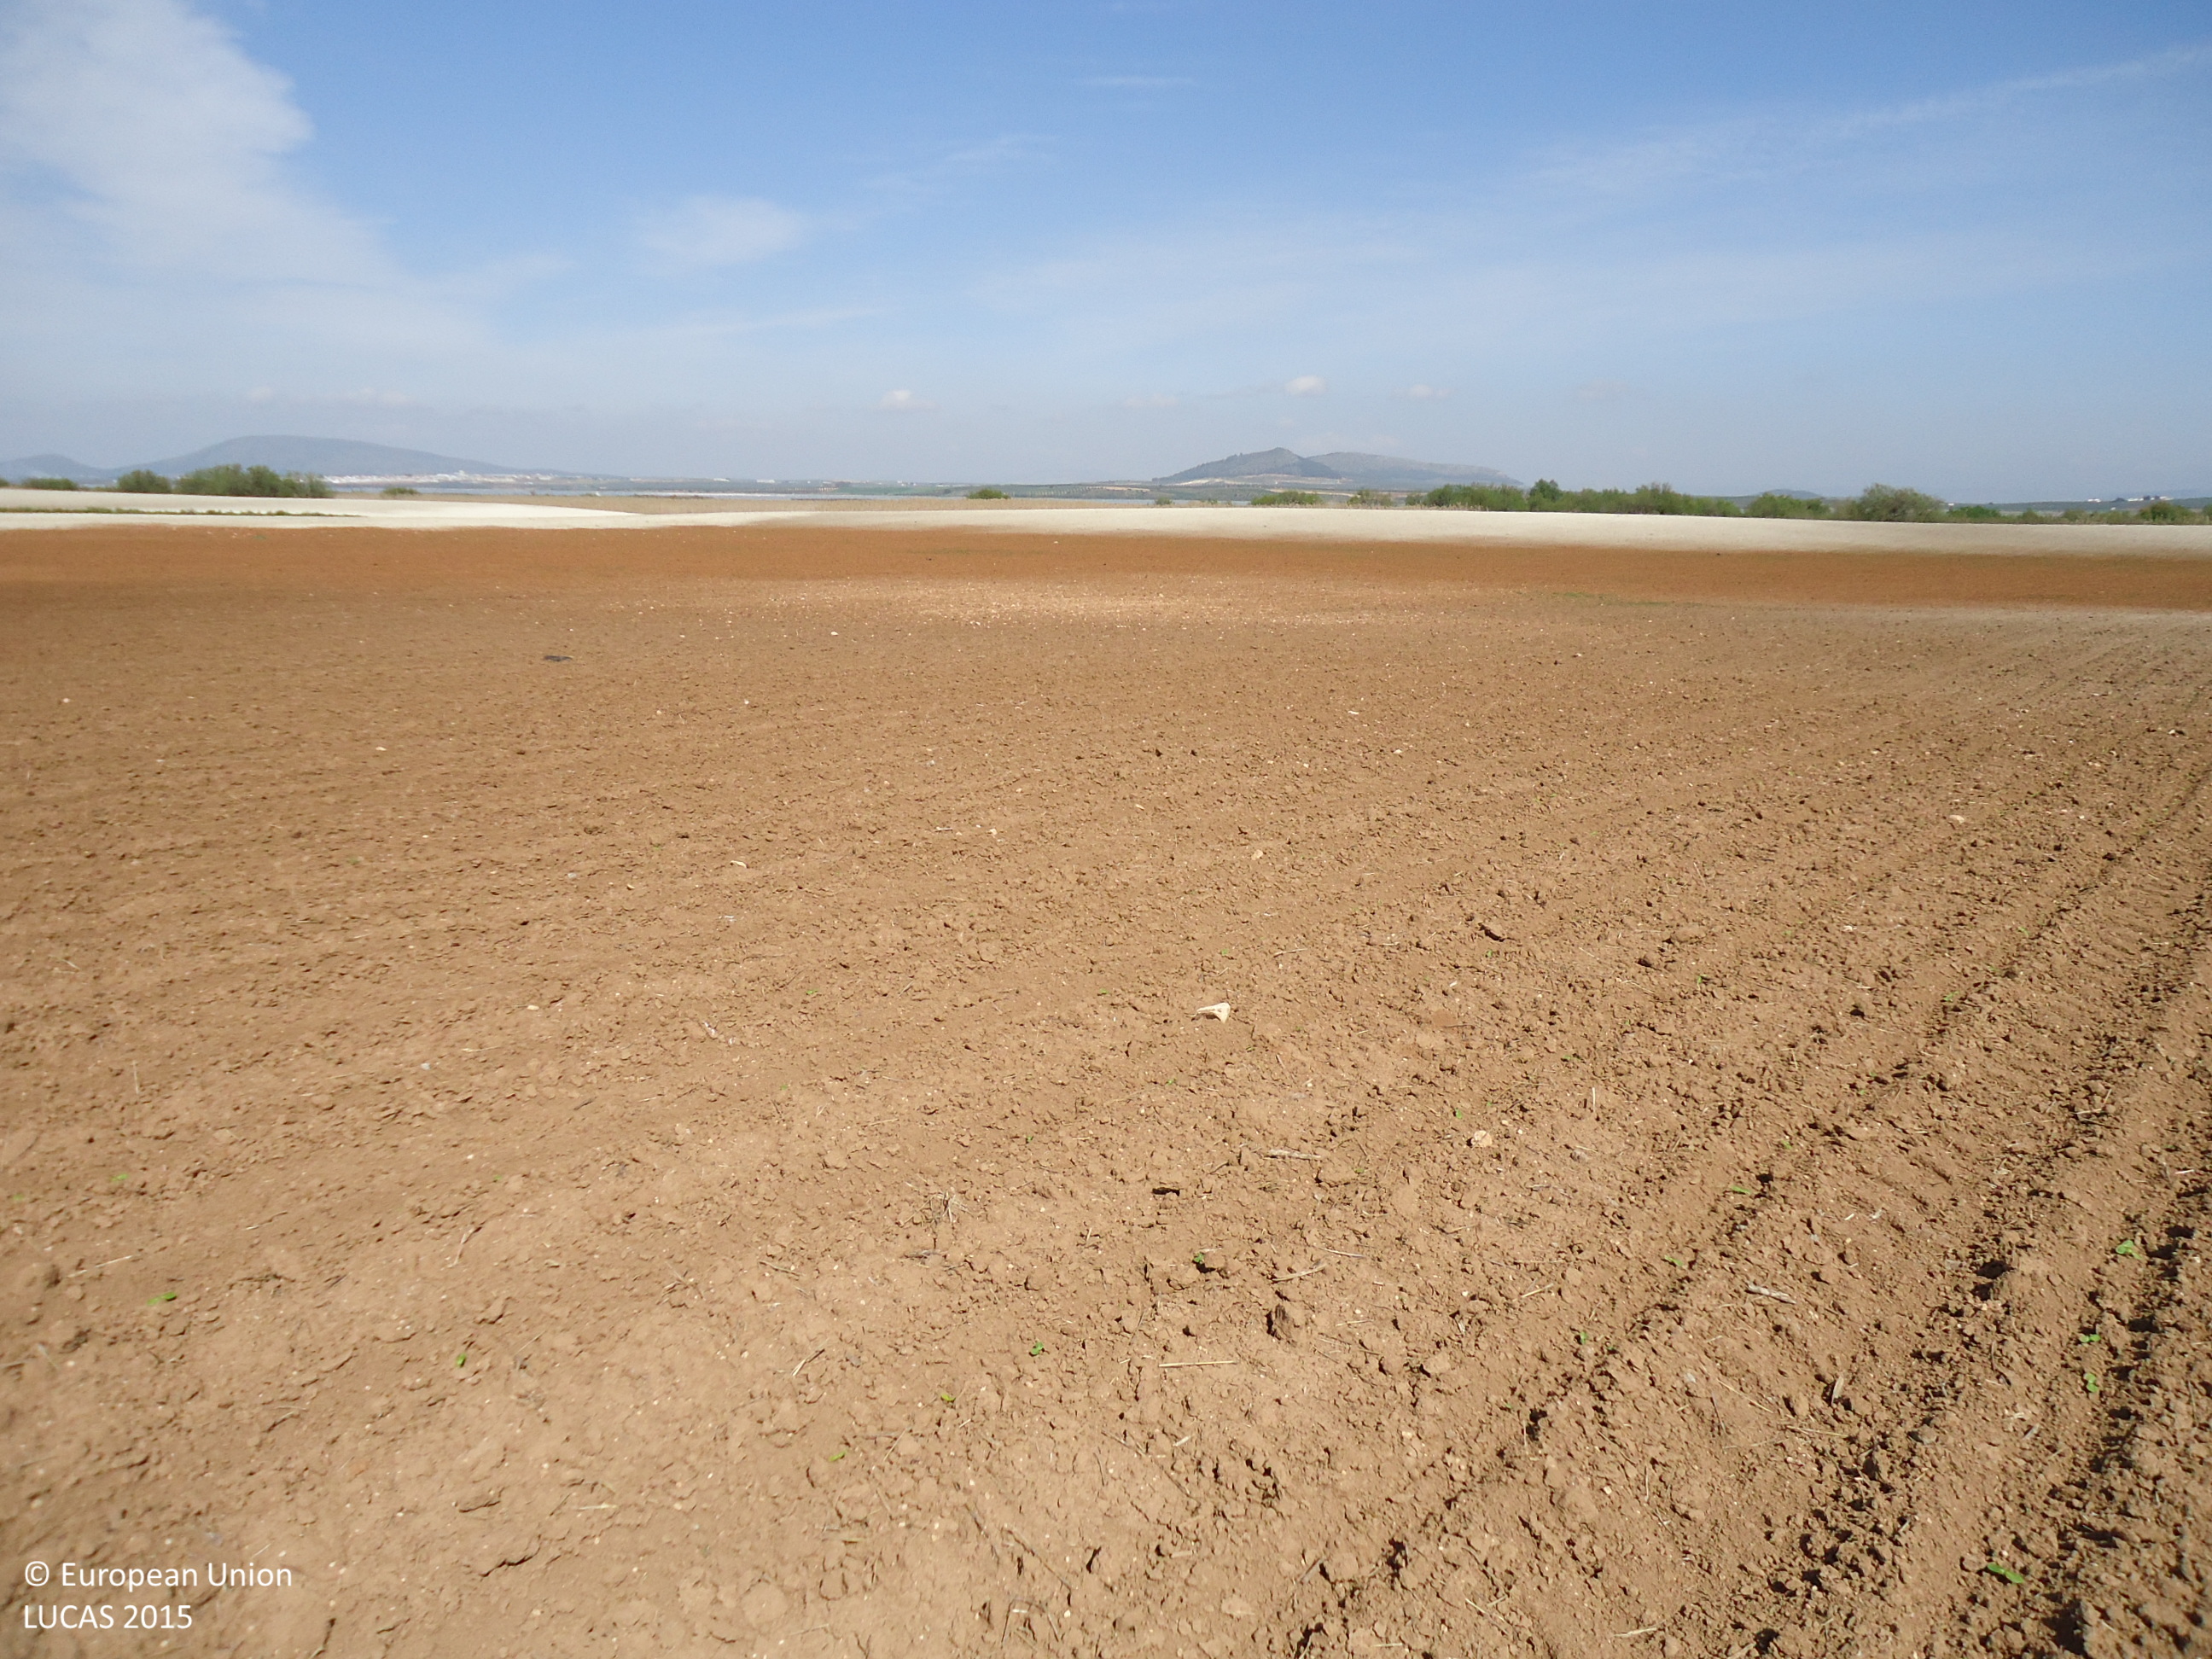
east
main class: Cropland
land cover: Sunflower
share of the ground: < 10 %
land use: Agriculture (excluding fallow land and kitchen gardens)
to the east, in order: Sunflower; Grass margins; Tracks; Grass margins; Grassland with sparse tree/shrub cover
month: April
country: ES
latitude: 37.0983
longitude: -4.7967
